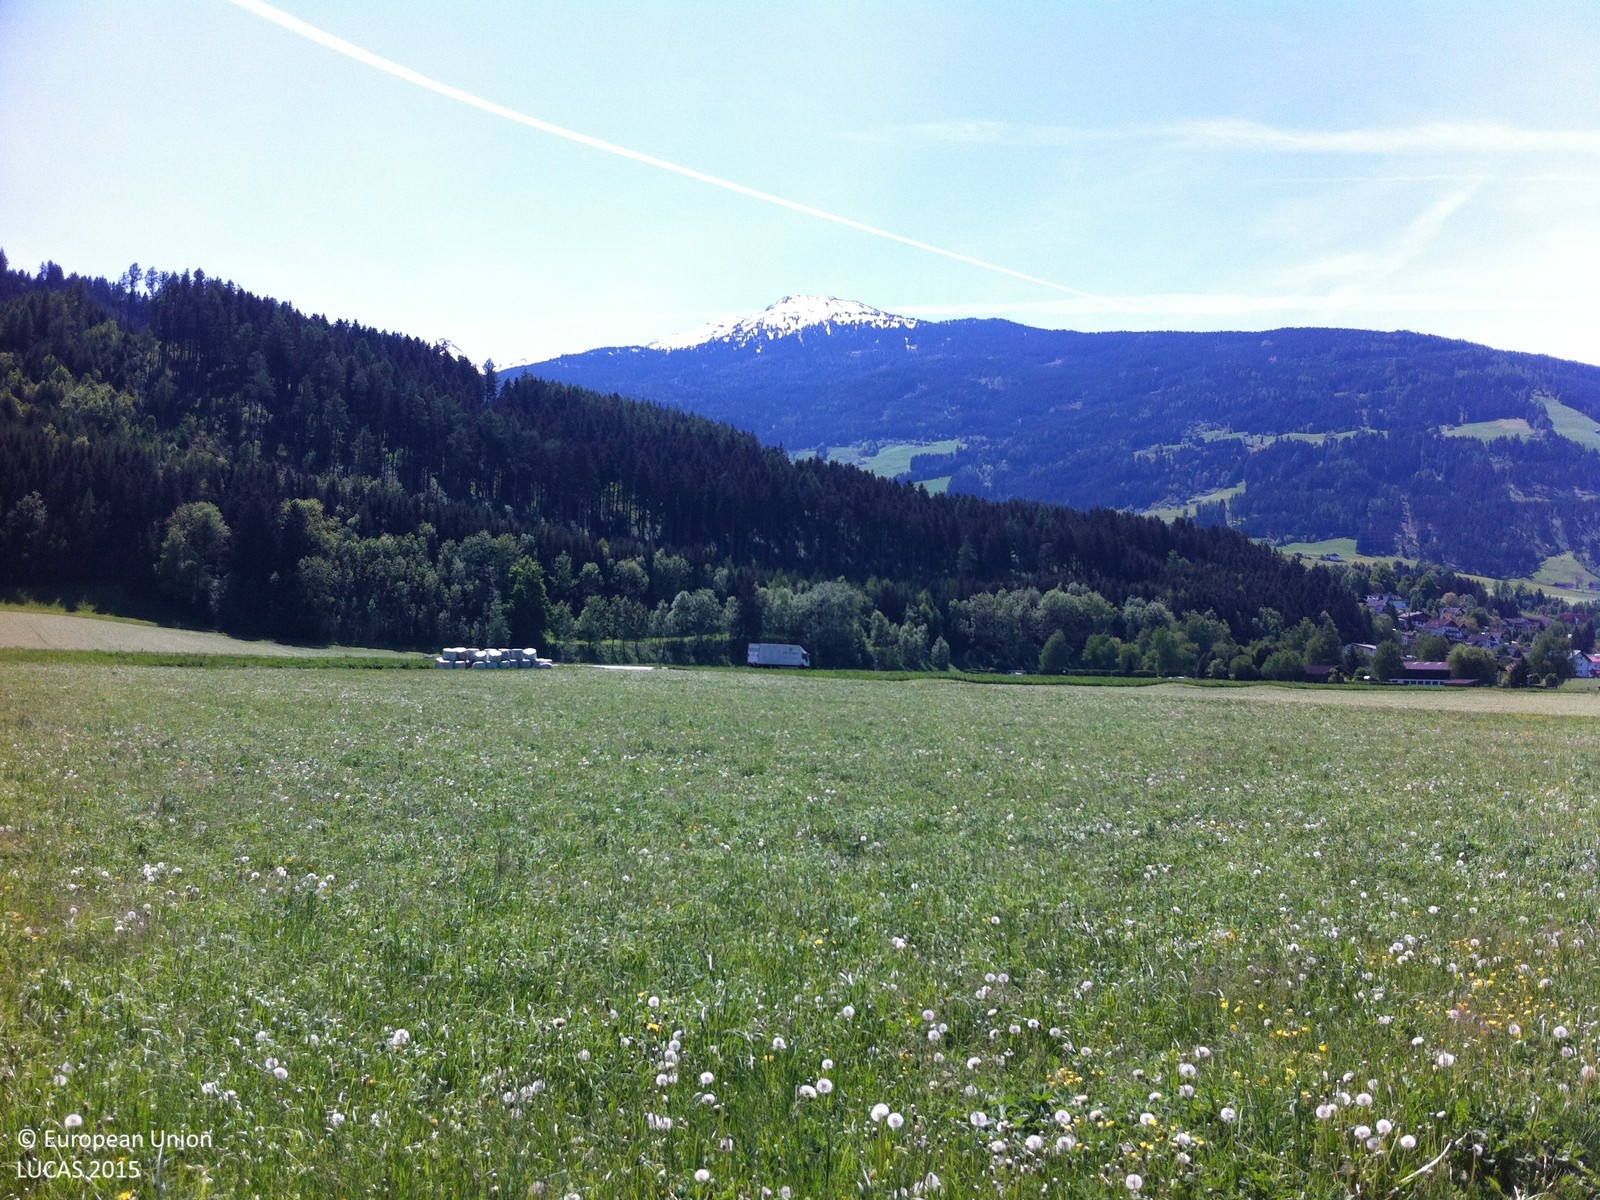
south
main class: Grassland
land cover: Grassland without tree/shrub cover
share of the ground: > 75 %
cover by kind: herbaceous plants 100 %
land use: Agriculture (excluding fallow land and kitchen gardens)
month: May
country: AT
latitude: 47.3111
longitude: 11.6521
